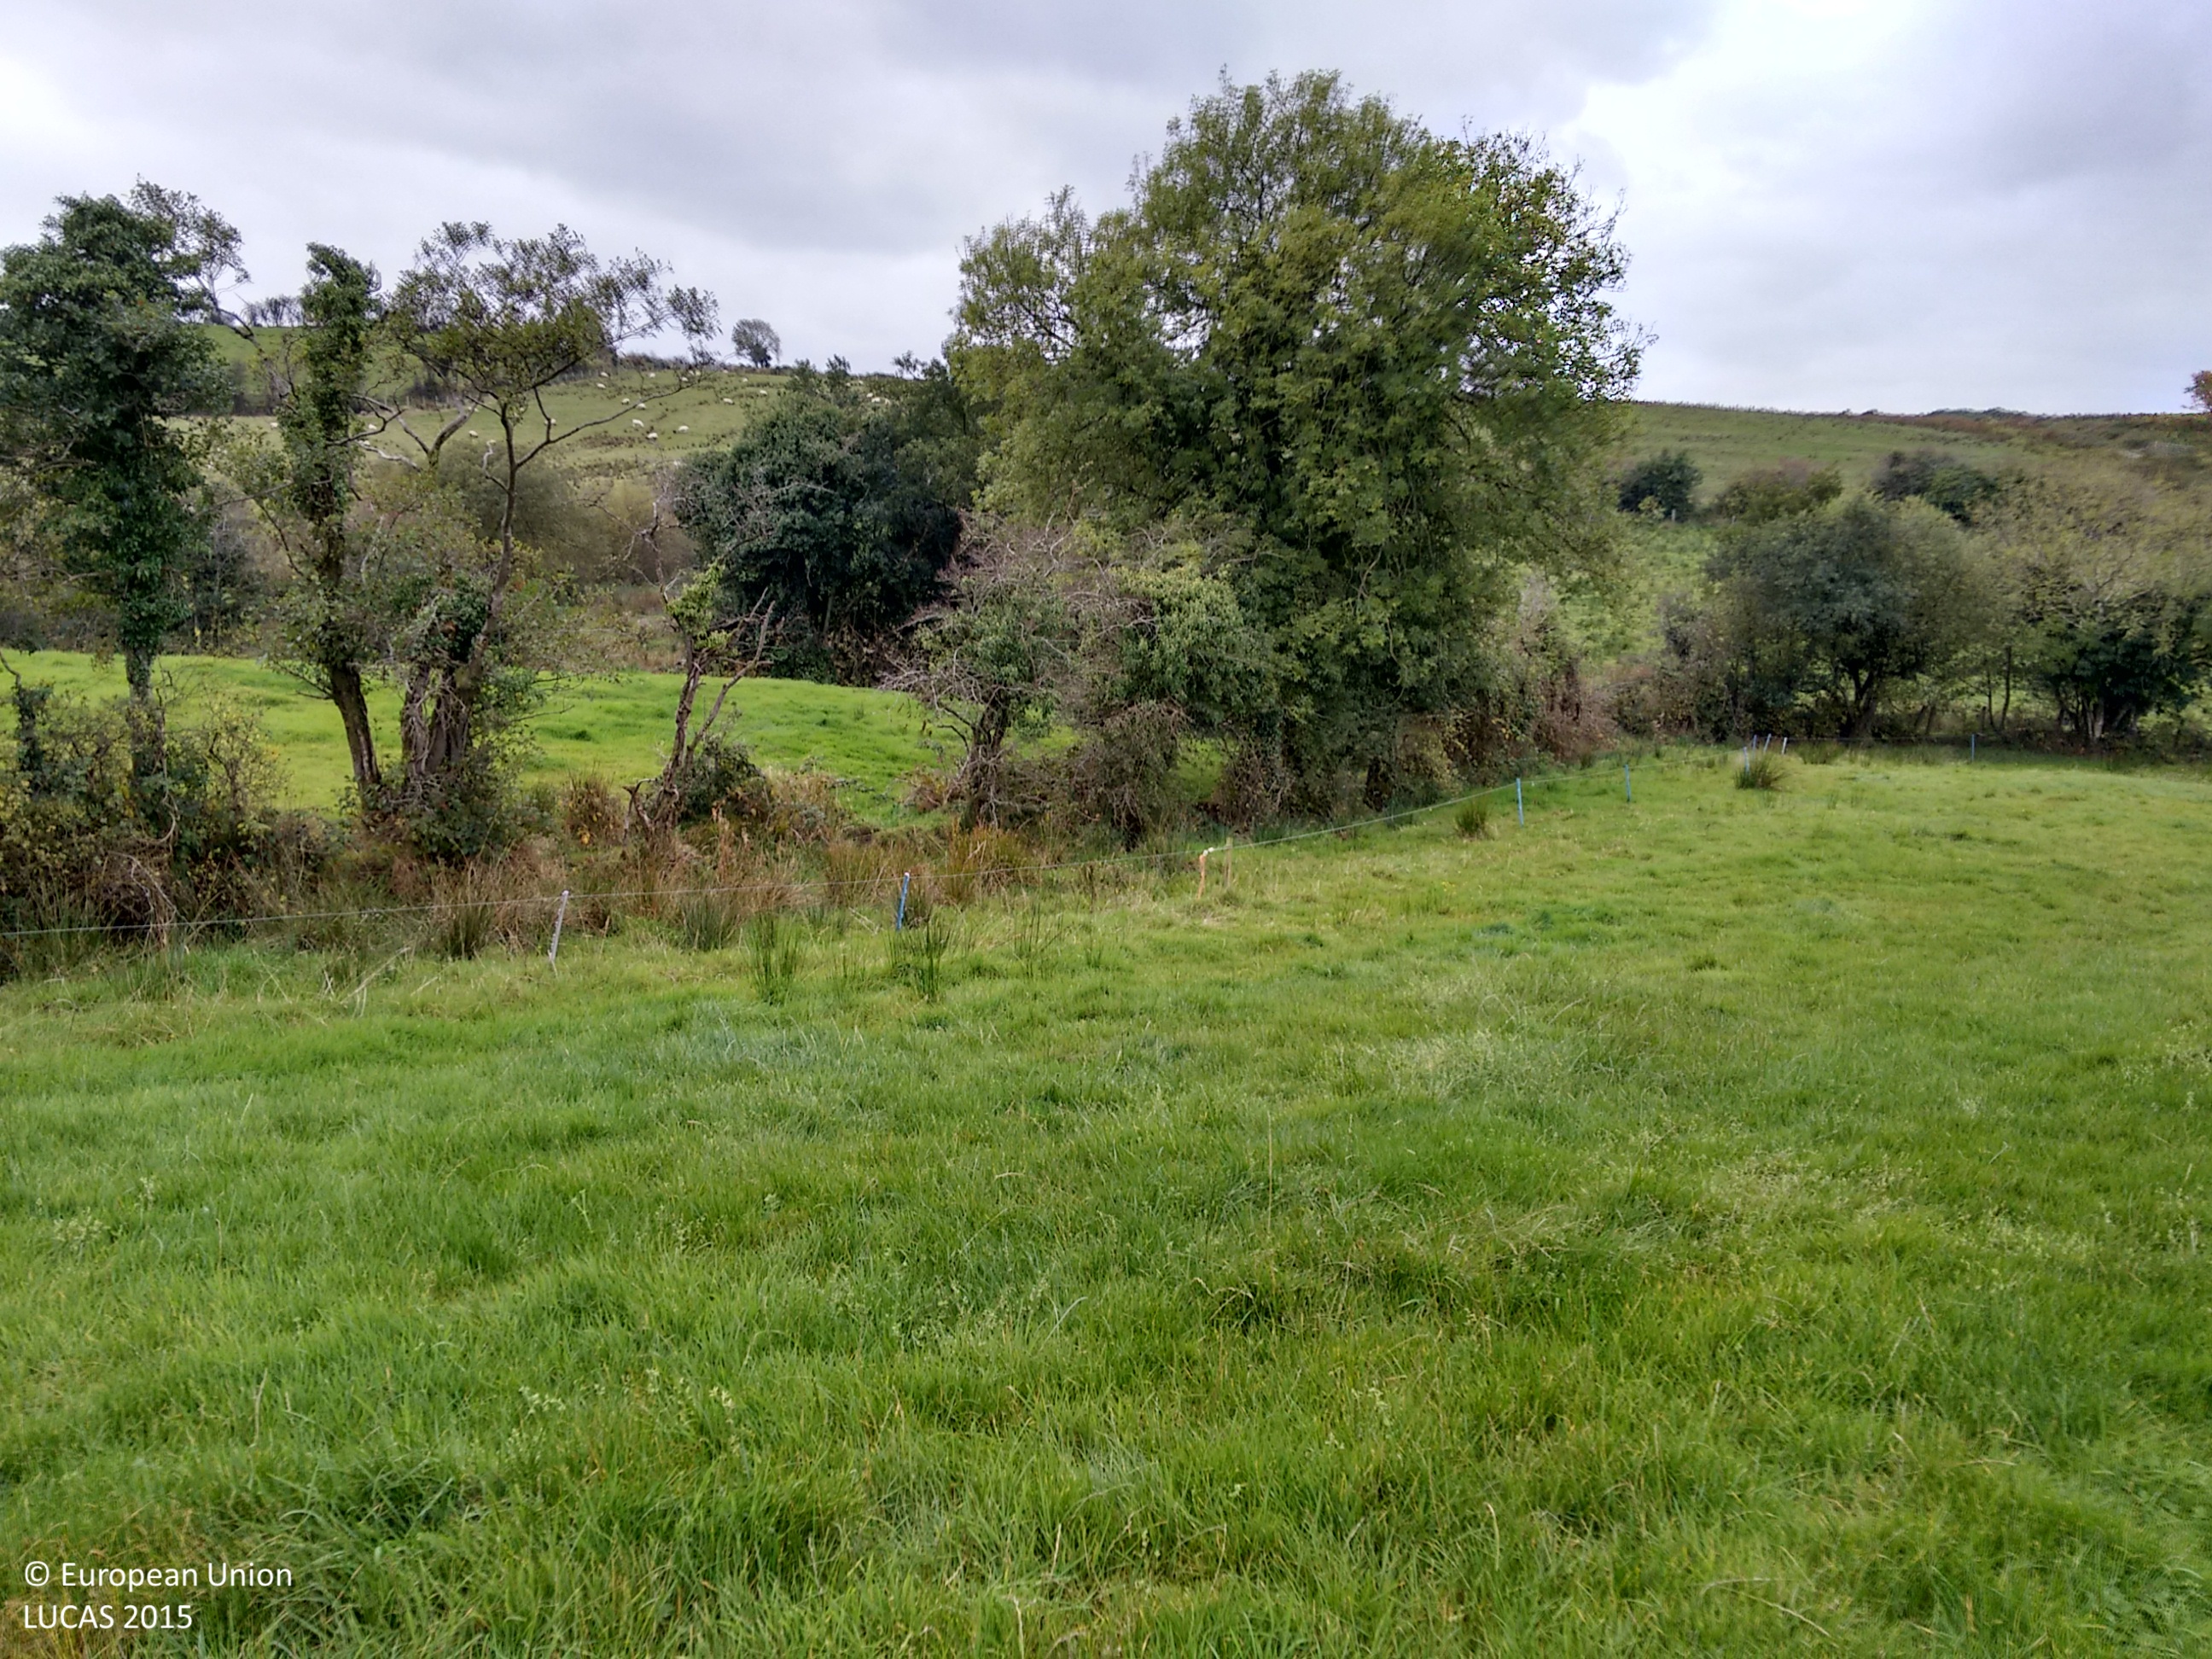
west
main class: Grassland
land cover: Grassland without tree/shrub cover
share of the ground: > 75 %
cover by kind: herbaceous plants 100 %
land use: Agriculture (excluding fallow land and kitchen gardens)
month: October
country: GB
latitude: 54.4353
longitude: -7.5001
